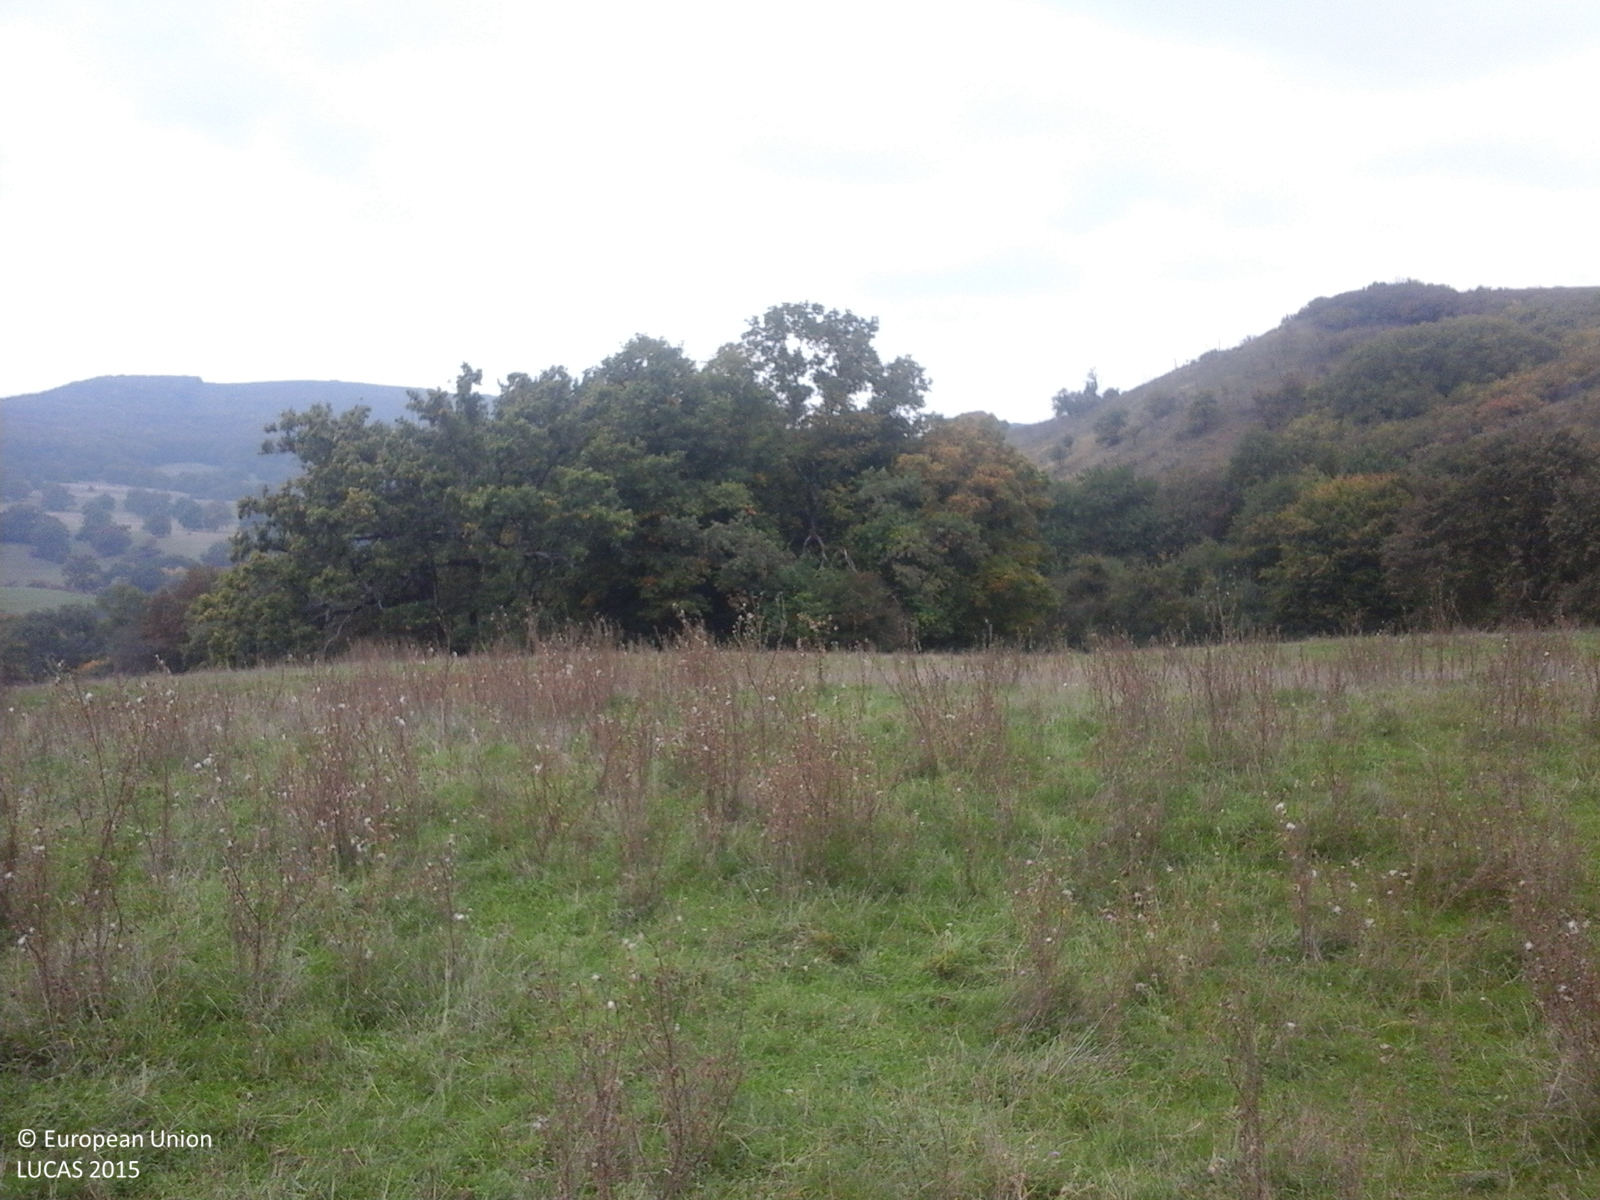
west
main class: Grassland
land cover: Grassland without tree/shrub cover
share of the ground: > 75 %
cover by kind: herbaceous plants 100 %
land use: Agriculture (excluding fallow land and kitchen gardens)
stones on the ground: < 10 %
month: October
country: RO
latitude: 46.1789
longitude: 24.8996
